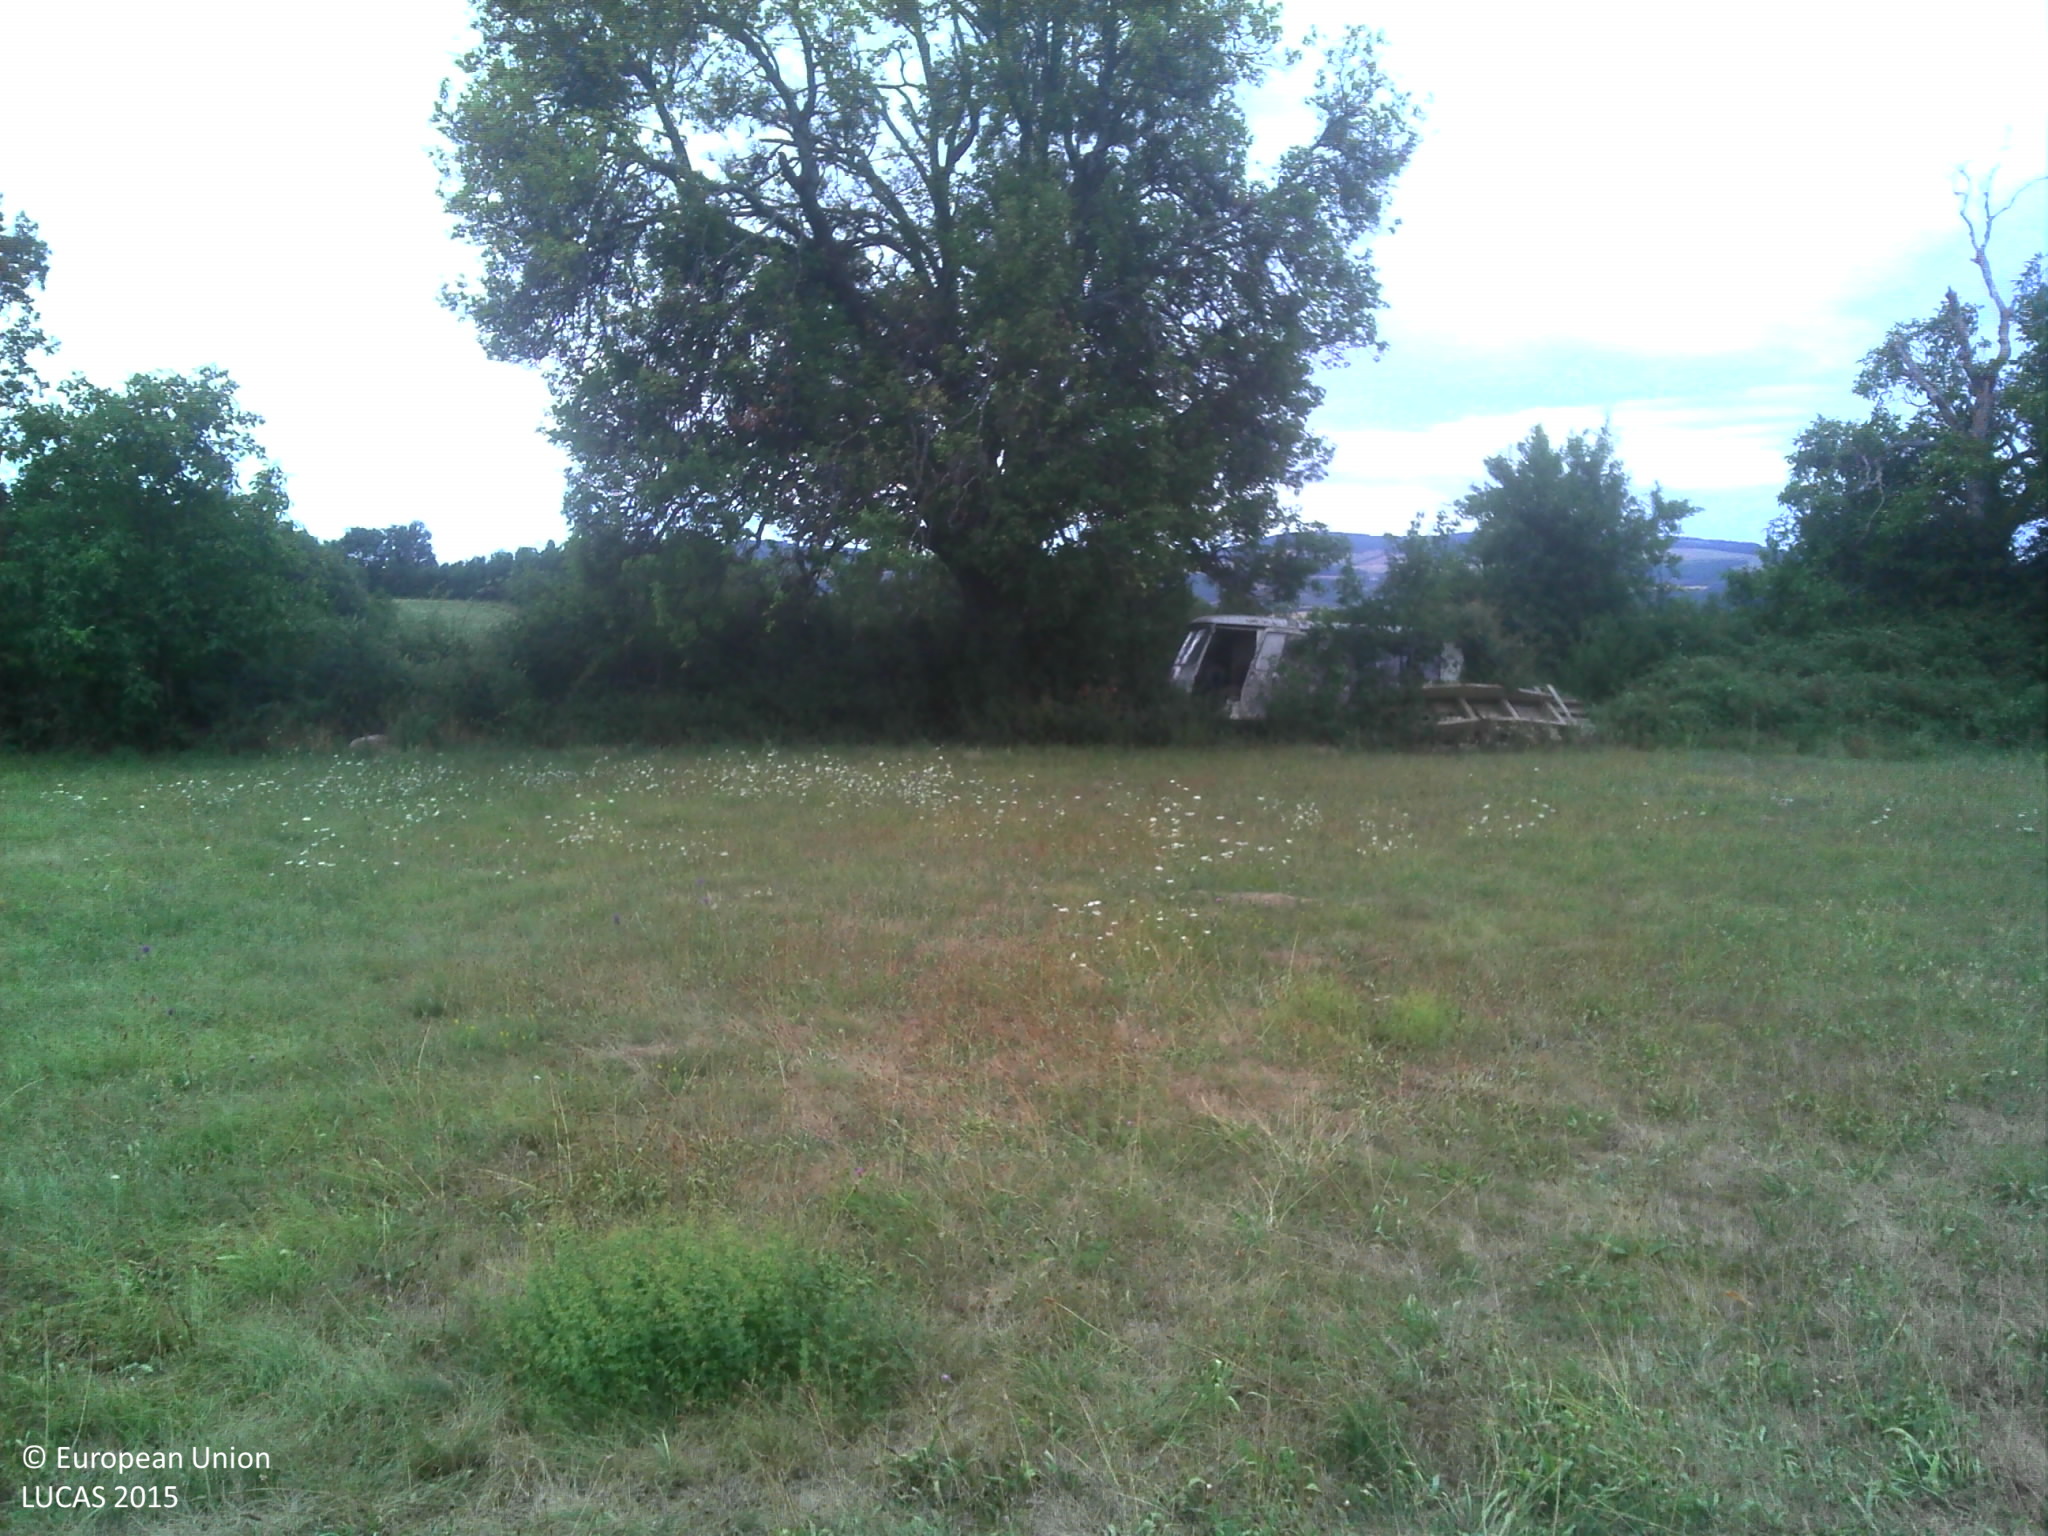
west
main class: Grassland
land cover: Grassland without tree/shrub cover
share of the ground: > 75 %
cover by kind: herbaceous plants 100 %
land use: Agriculture (excluding fallow land and kitchen gardens)
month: July
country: FR
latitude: 44.0385
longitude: 5.5532
